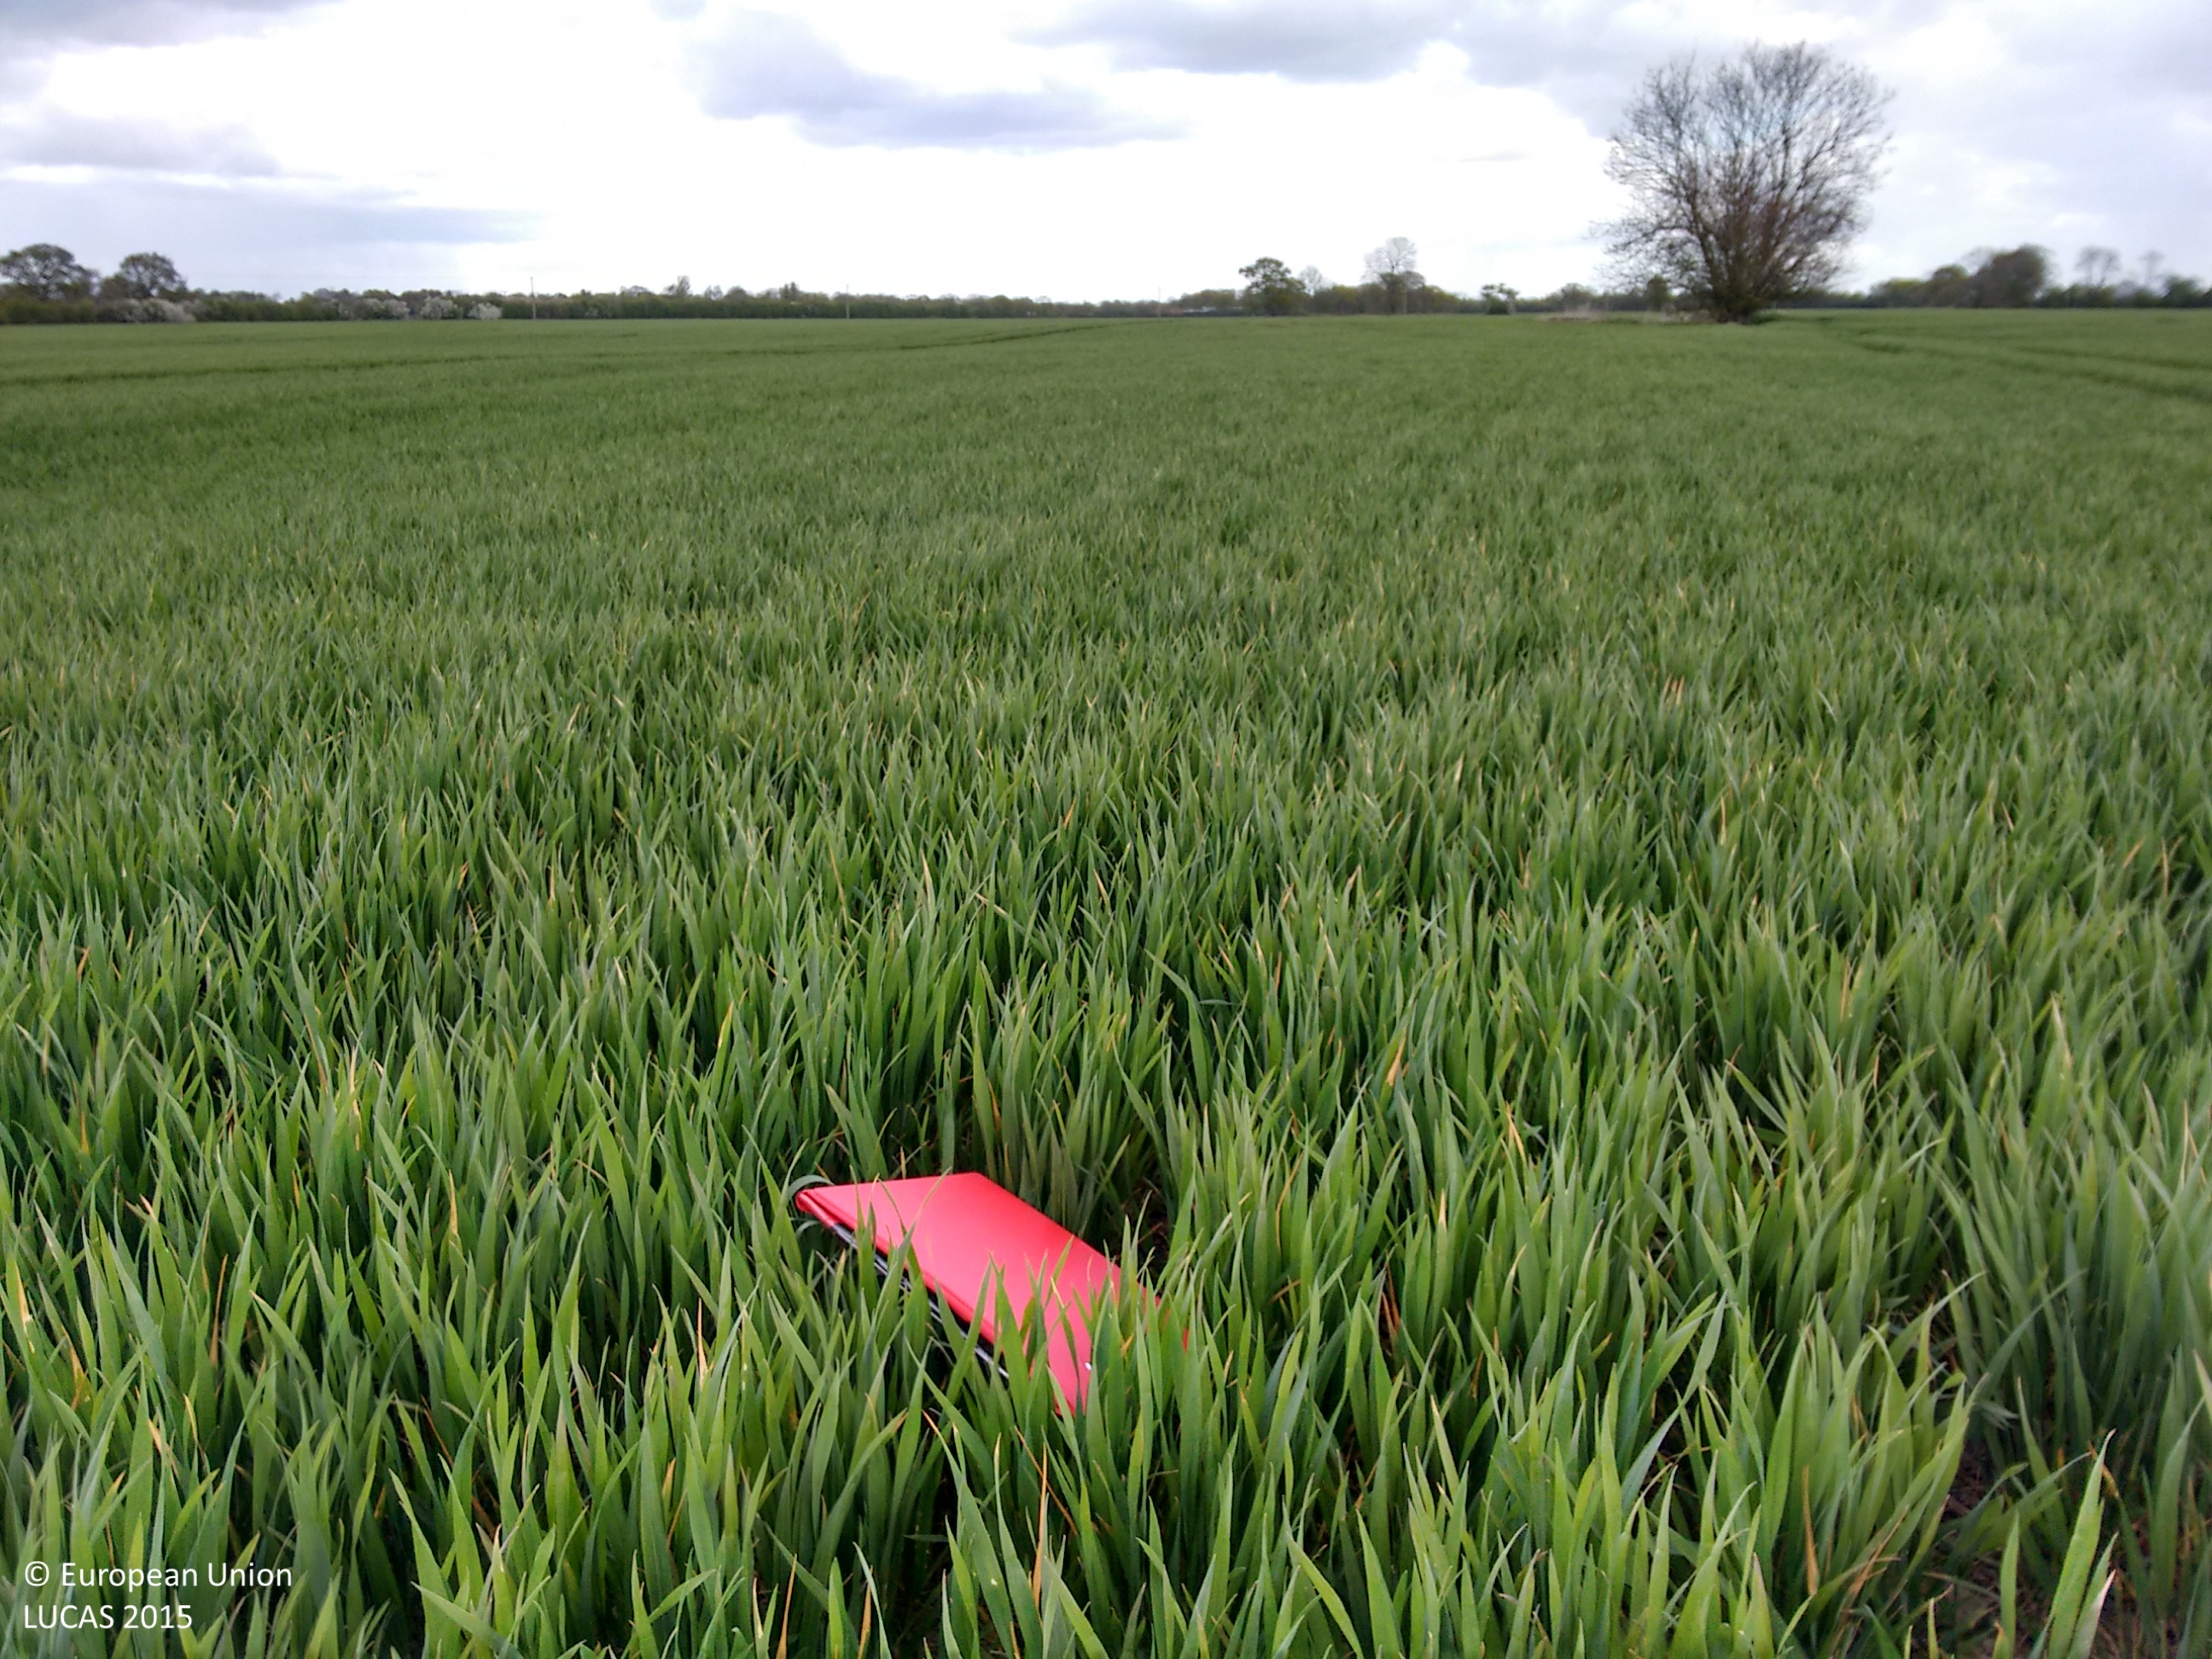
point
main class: Cropland
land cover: Barley
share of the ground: > 75 %
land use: Agriculture (excluding fallow land and kitchen gardens)
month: April
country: GB
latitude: 53.7501
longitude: -0.8230
